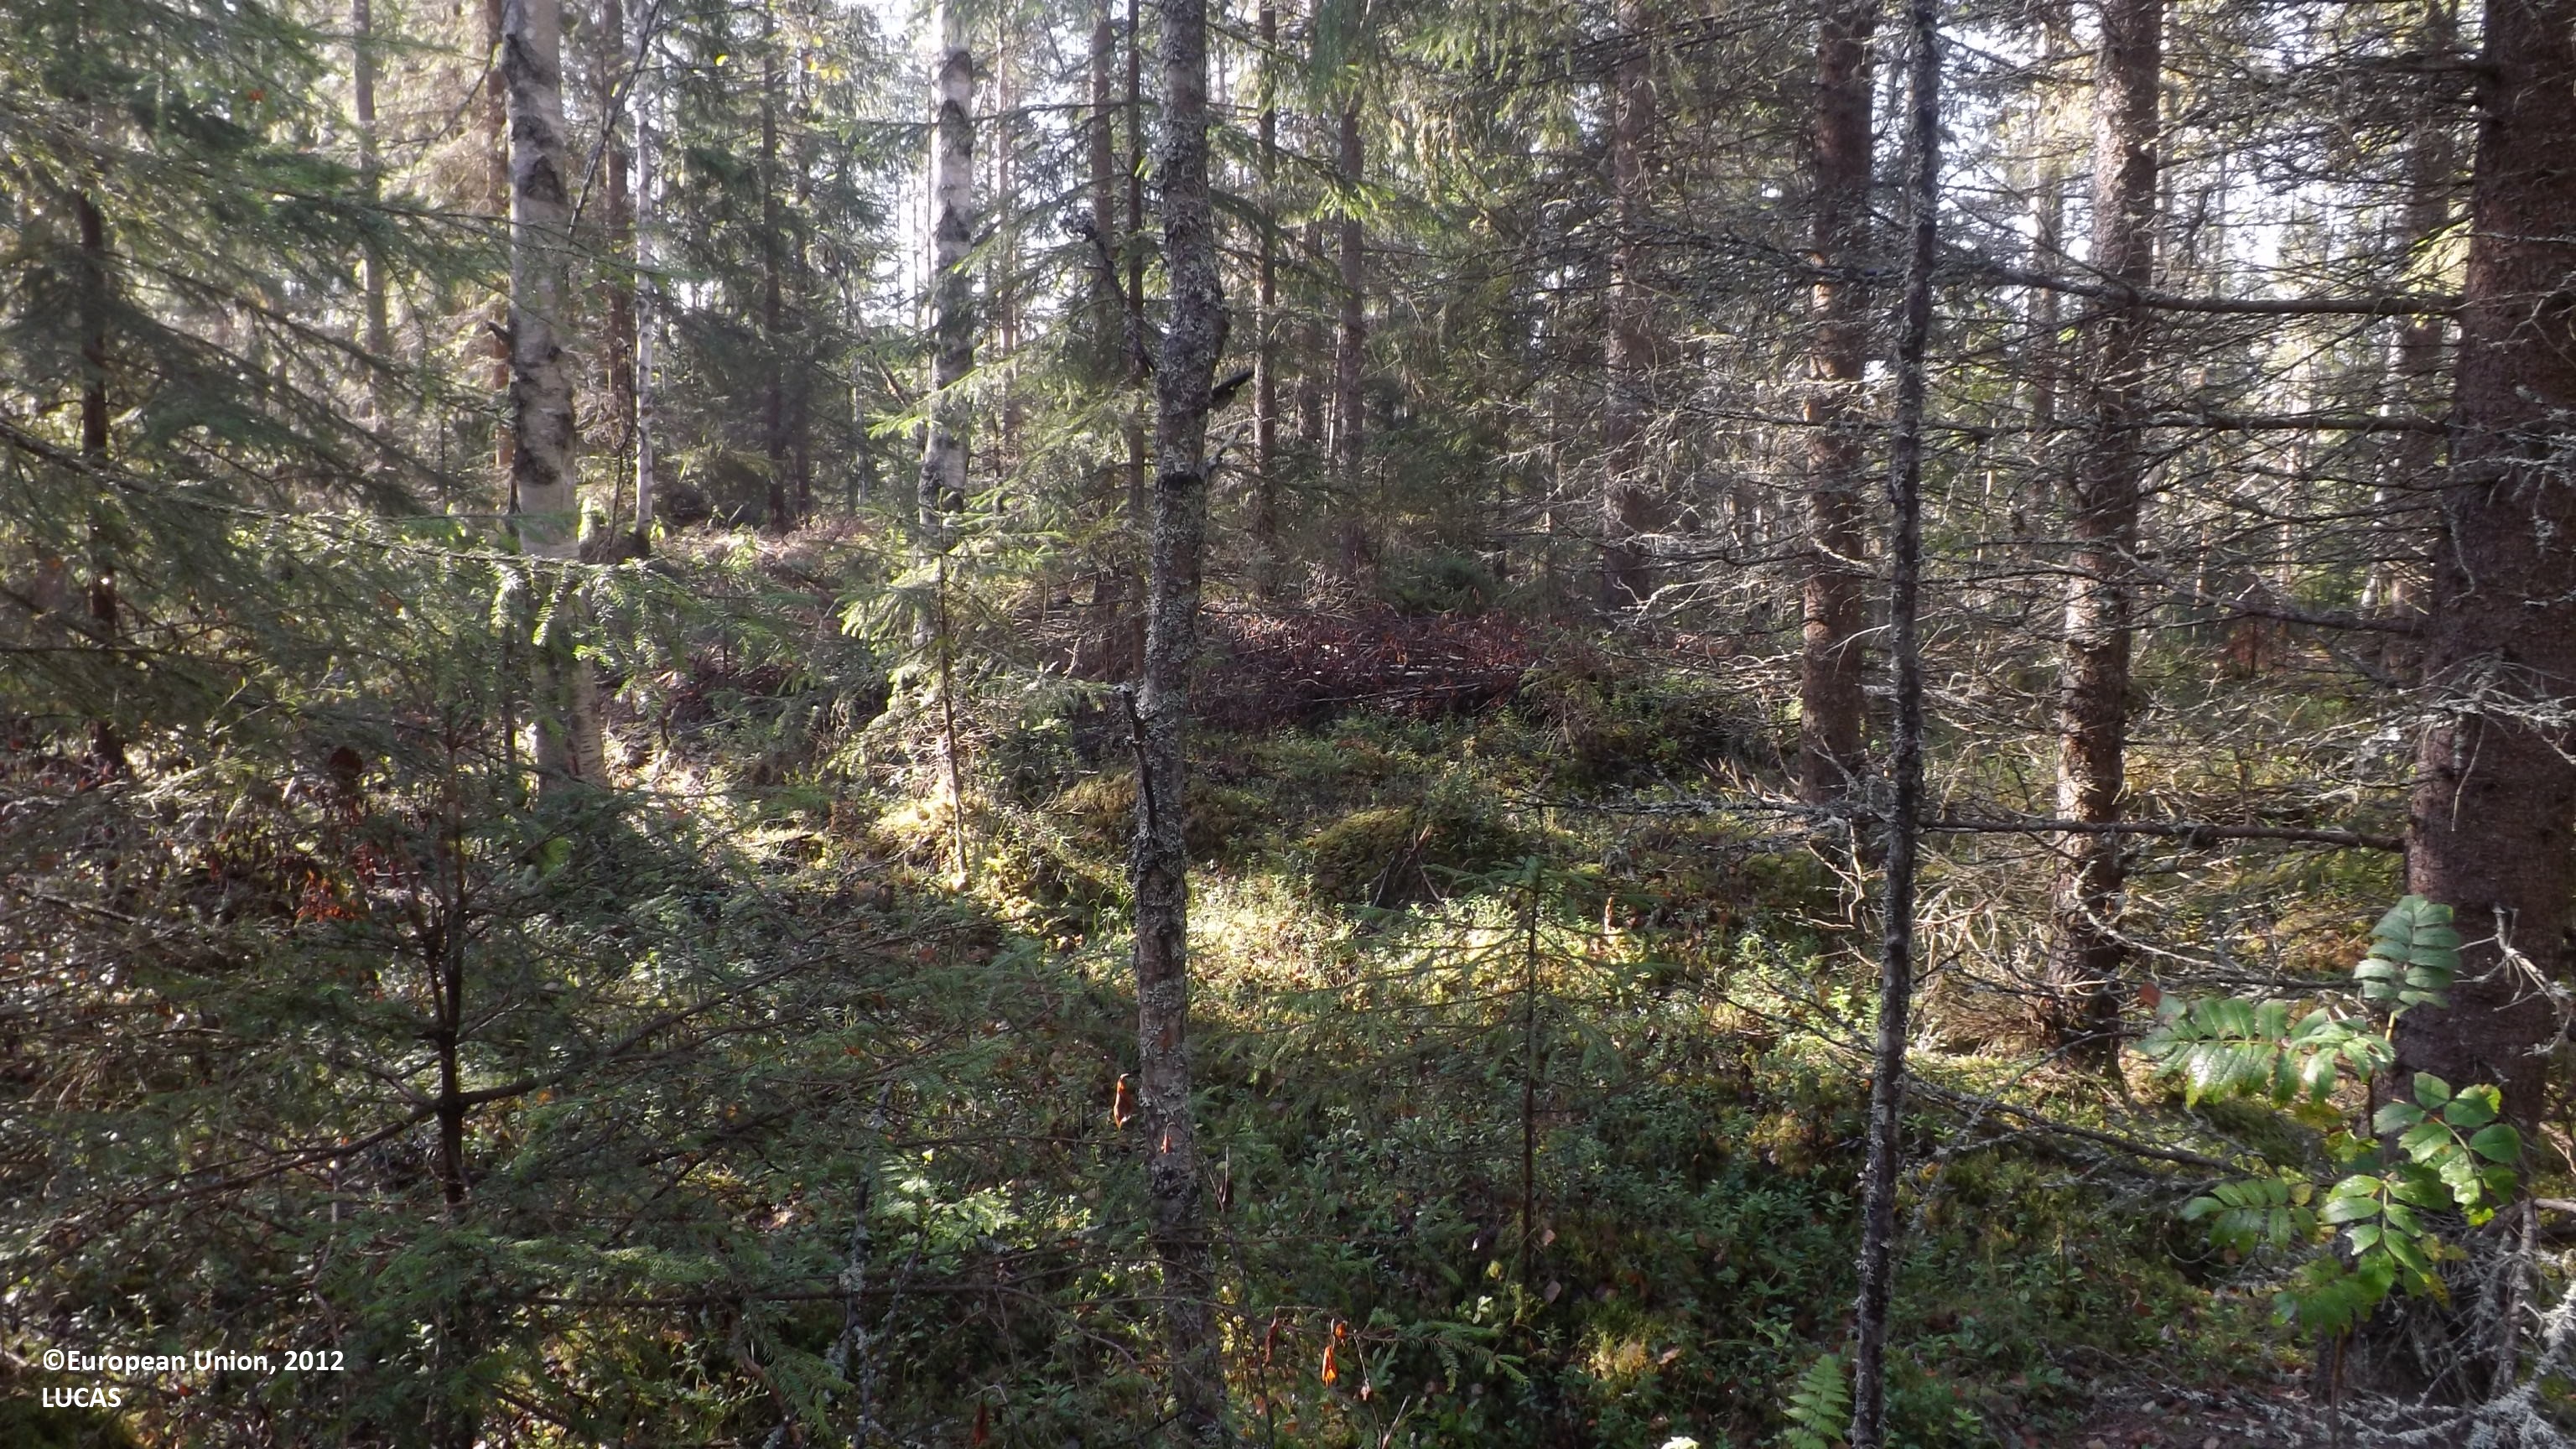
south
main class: Woodland
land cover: Spruce dominated mixed woodland
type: boreal forest
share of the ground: 50 - 75 %
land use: Forestry
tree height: > 5 m
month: August
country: FI
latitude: 63.6467
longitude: 23.7751
